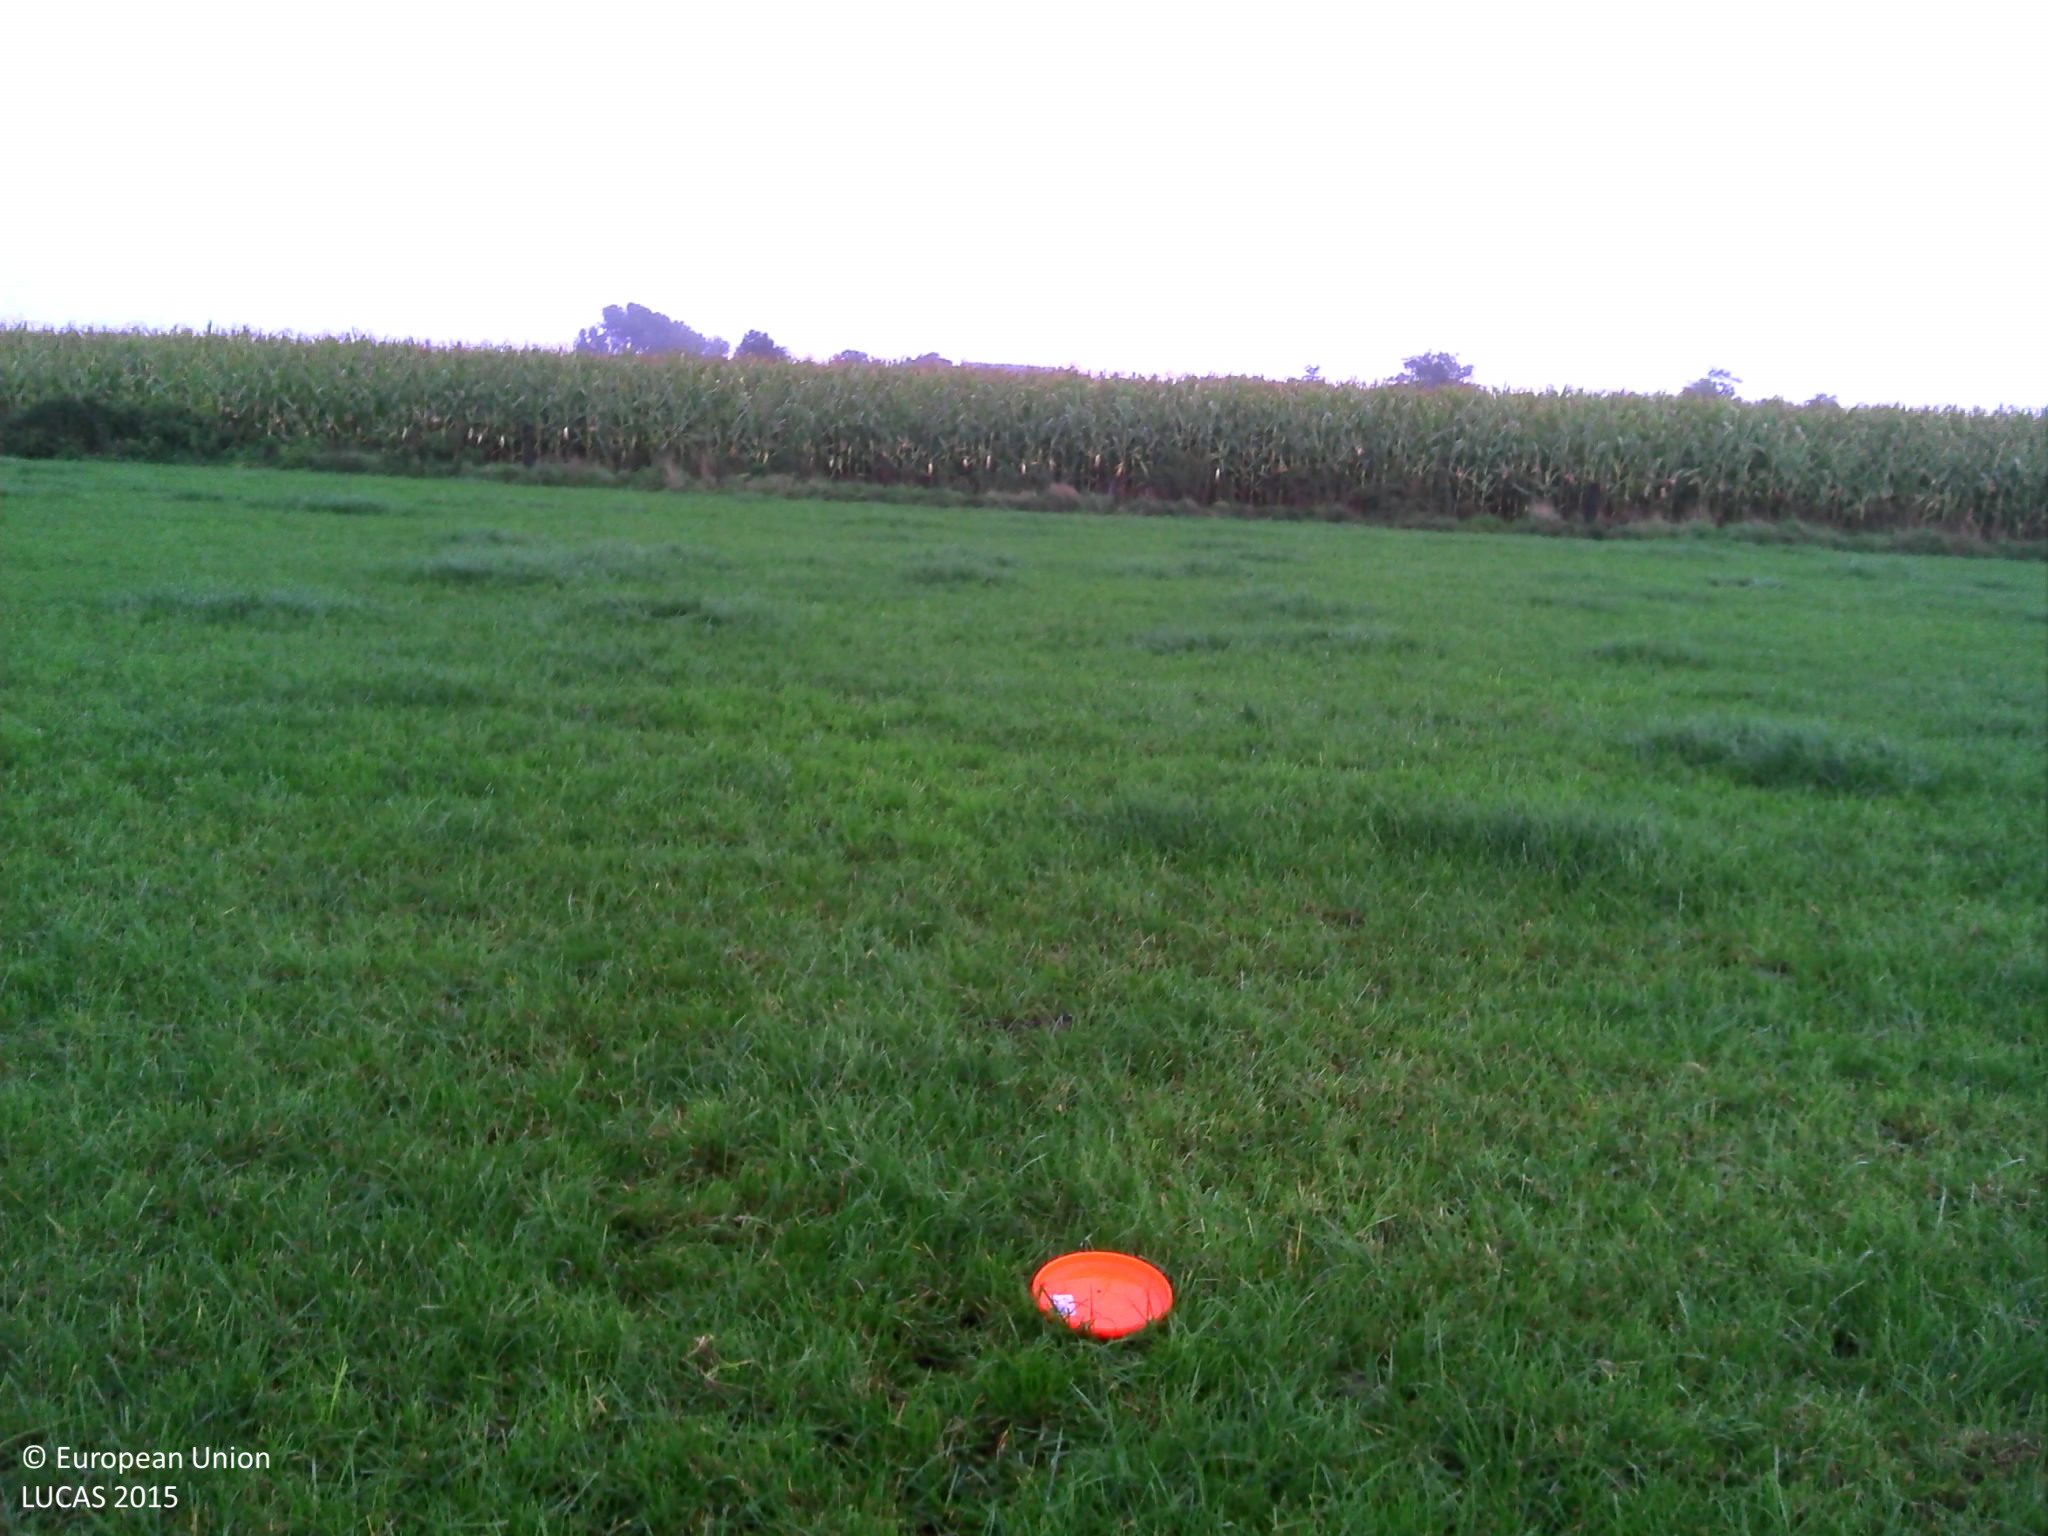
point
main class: Cropland
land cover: Temporary grasslands
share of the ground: > 75 %
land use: Agriculture (excluding fallow land and kitchen gardens)
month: September
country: BE
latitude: 51.3608
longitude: 4.7545
